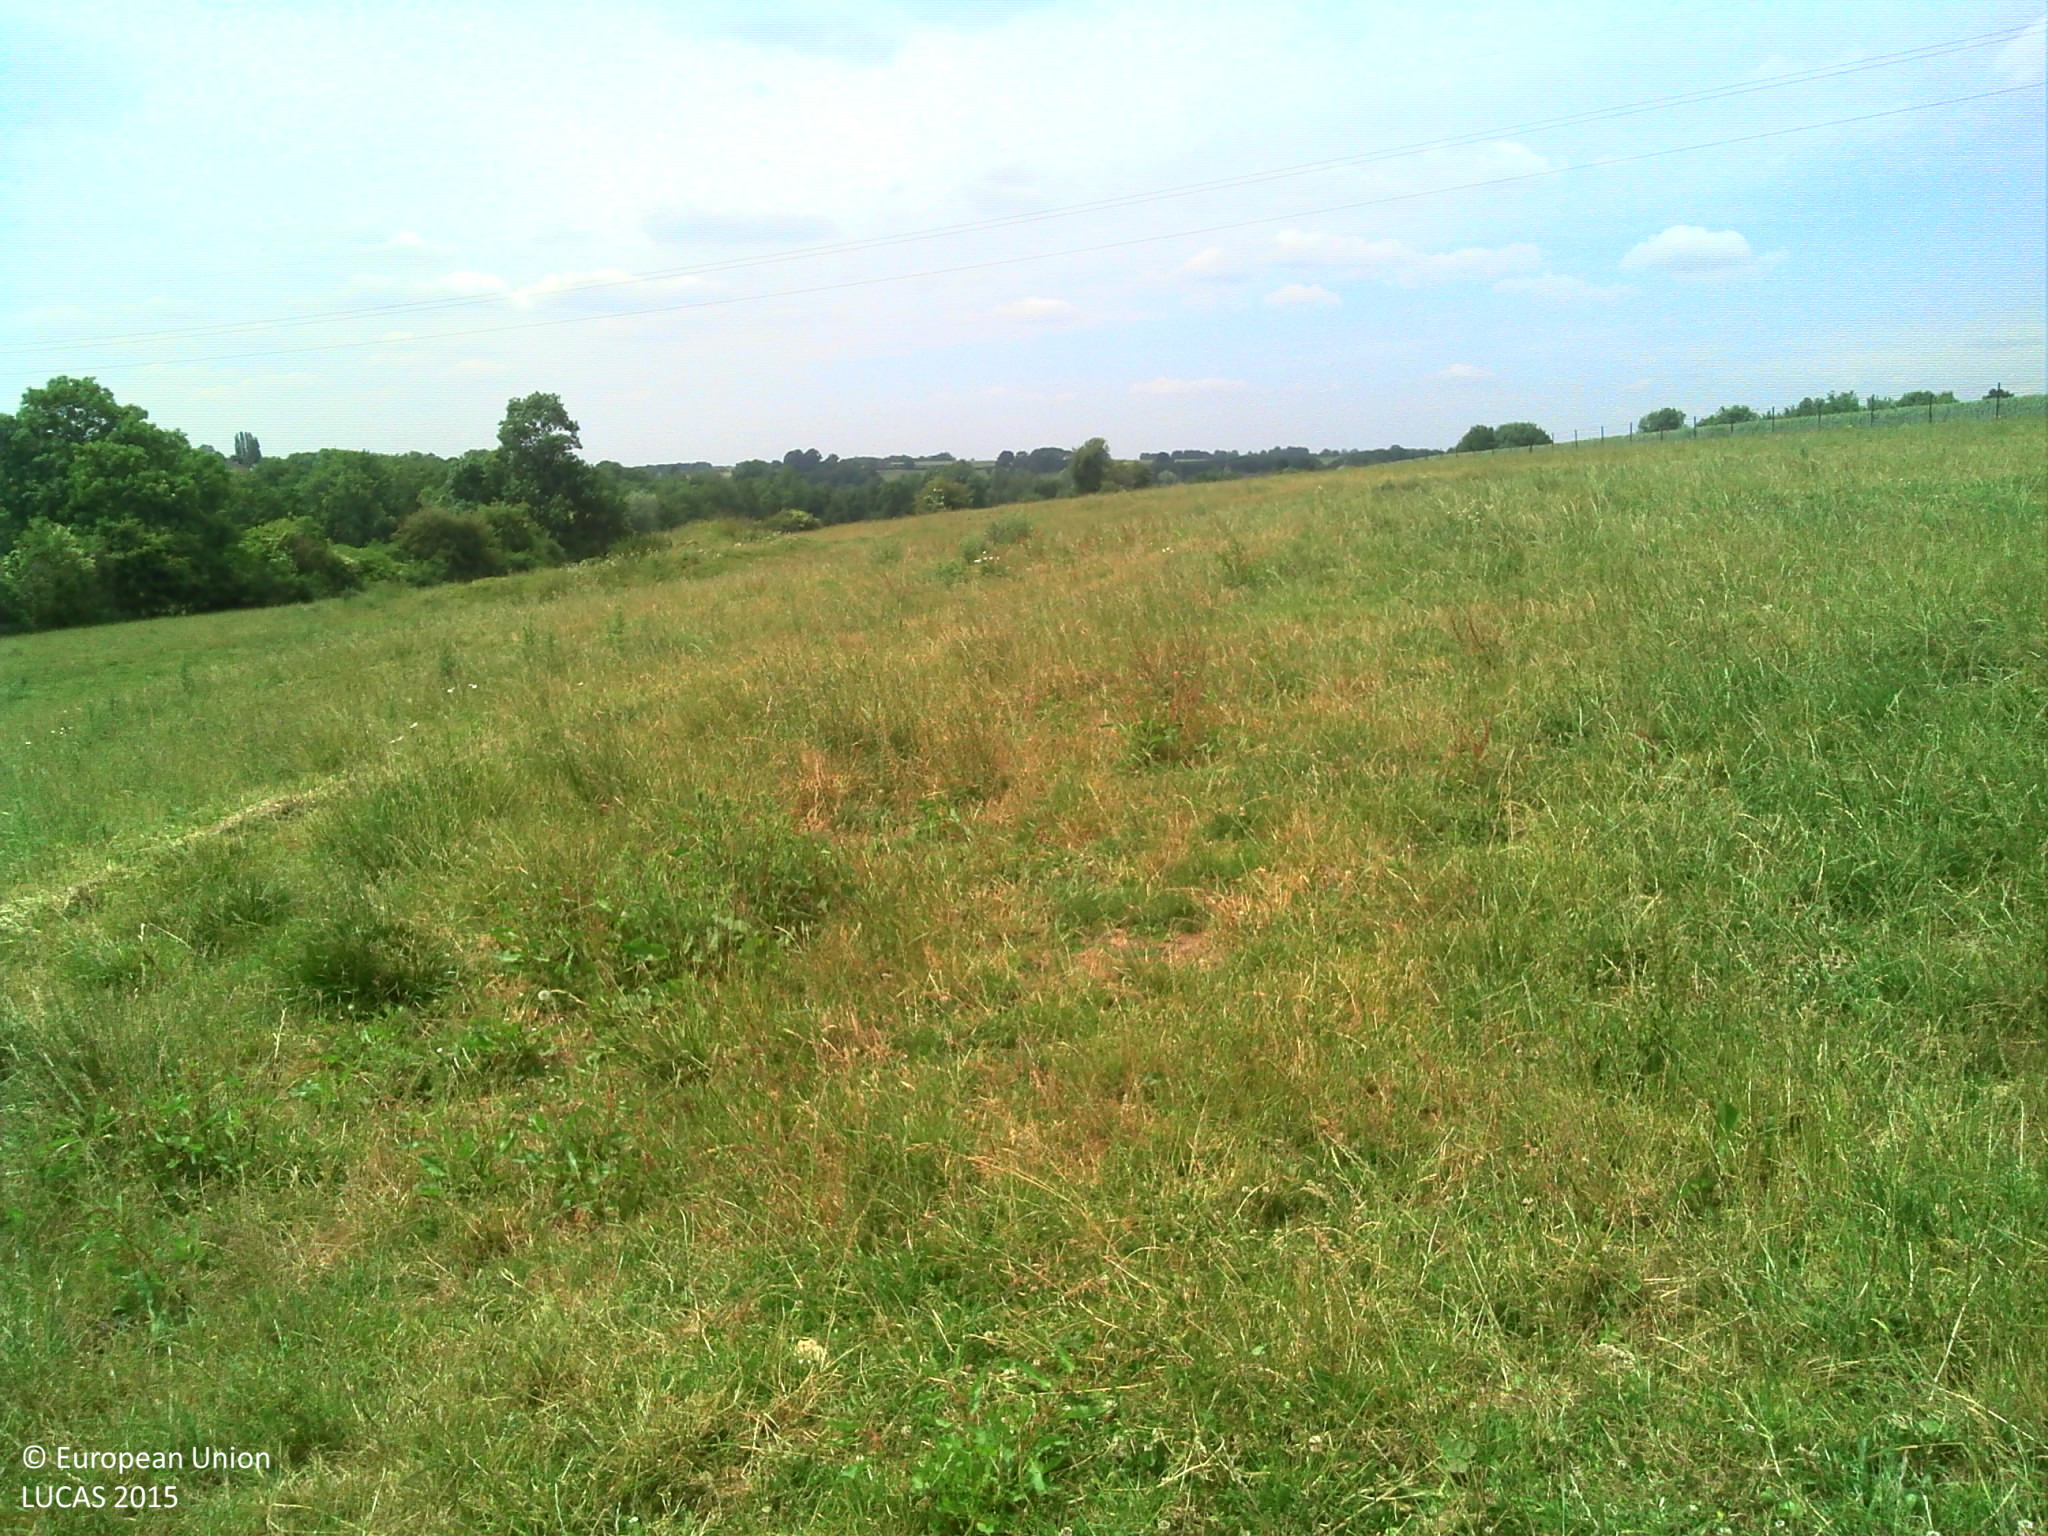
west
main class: Grassland
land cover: Grassland without tree/shrub cover
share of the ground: > 75 %
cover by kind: herbaceous plants 100 %
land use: Agriculture (excluding fallow land and kitchen gardens)
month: June
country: FR
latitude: 49.8460
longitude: 4.0007
